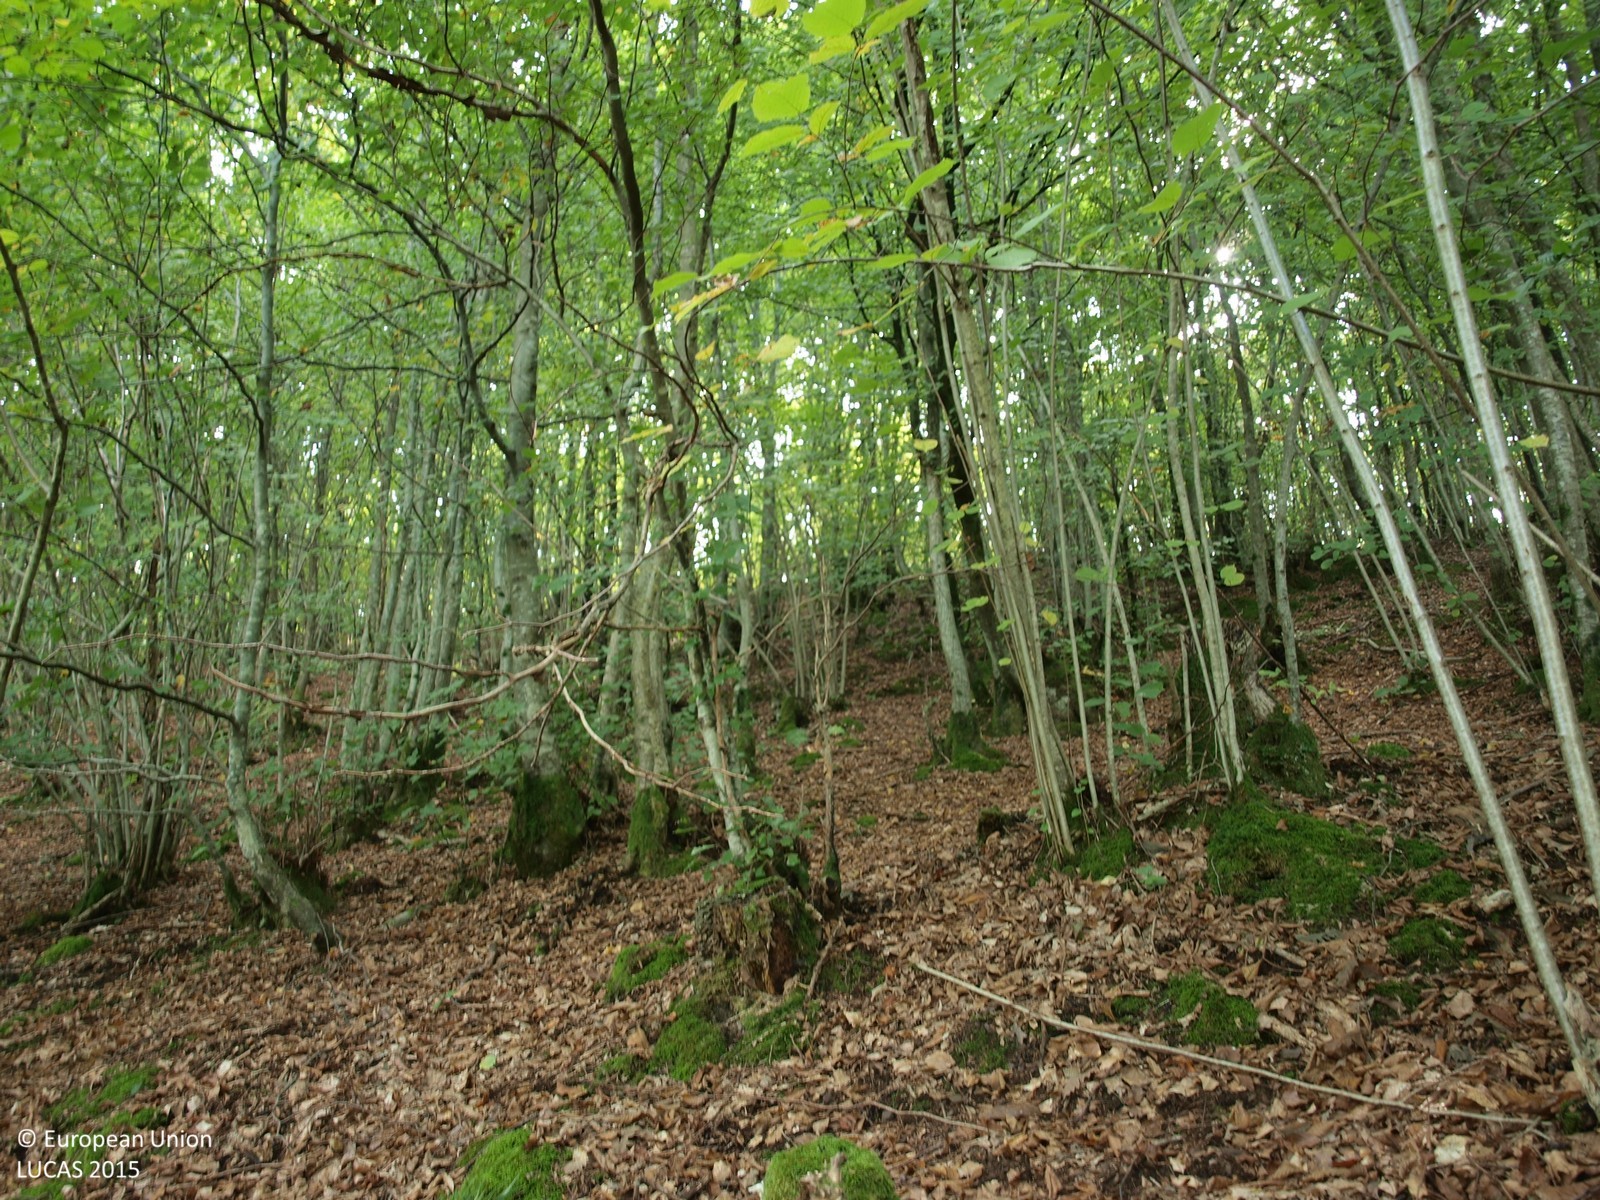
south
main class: Woodland
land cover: Broadleaved woodland
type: mesophytic deciduous forest
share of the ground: > 75 %
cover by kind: broadleaved forest trees 100 %
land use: Forestry
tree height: > 5 m
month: October
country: HR
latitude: 45.2673
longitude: 15.8972
